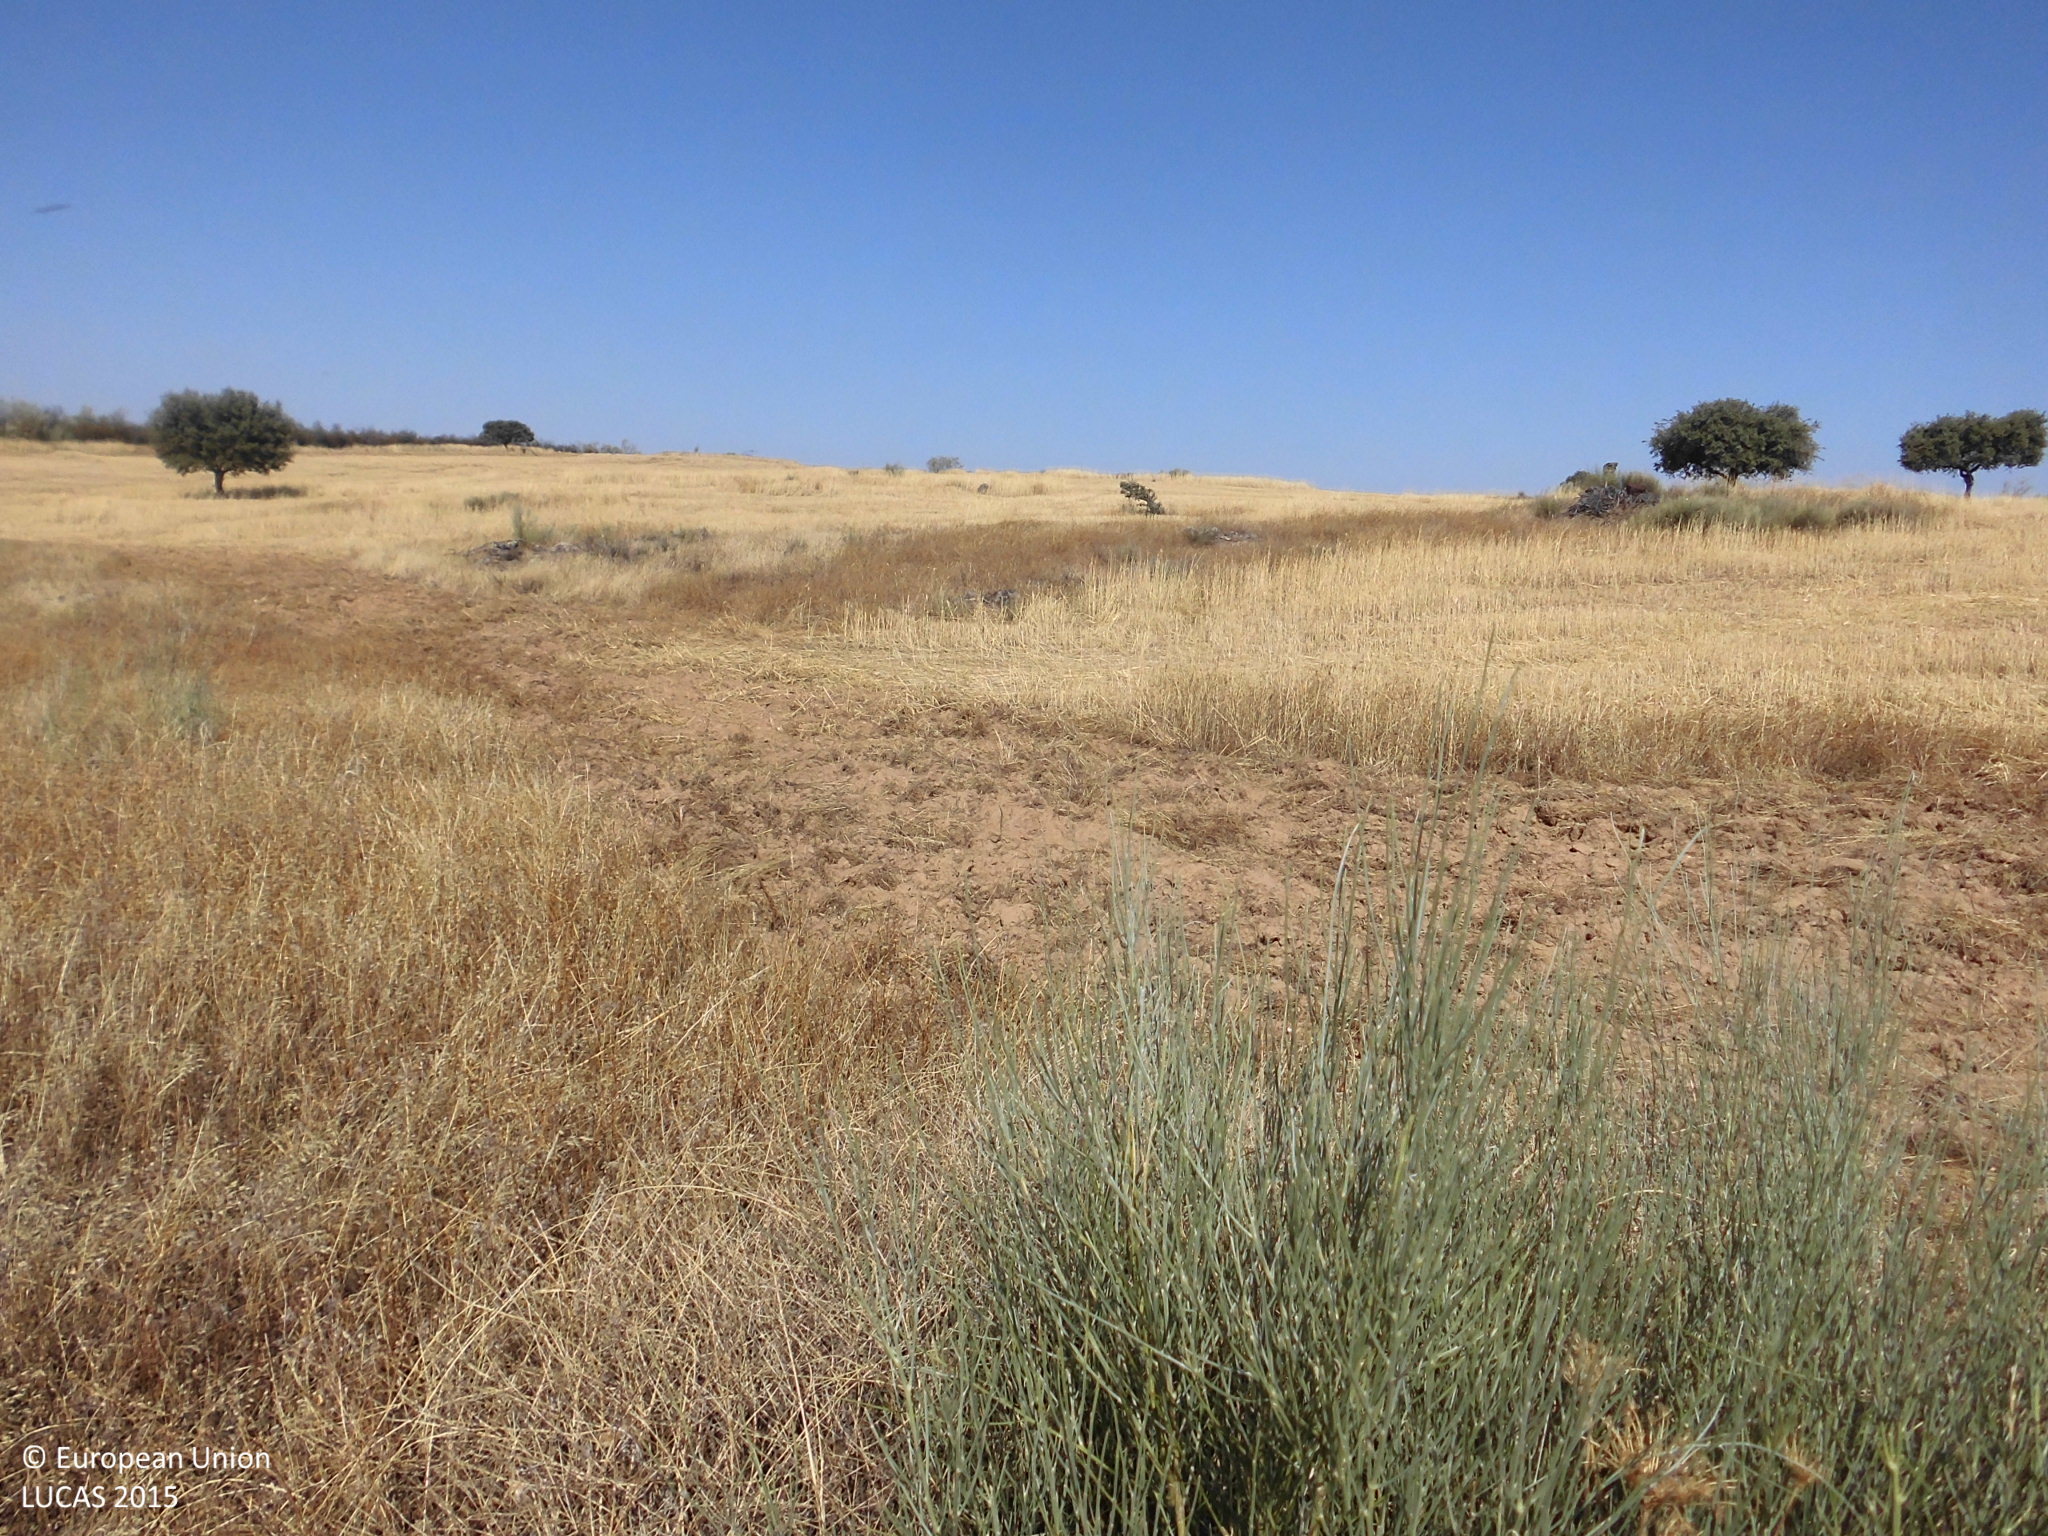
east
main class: Grassland
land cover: Grassland without tree/shrub cover
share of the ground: > 75 %
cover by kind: herbaceous plants 95 %, shrubs 5 %
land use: Agriculture (excluding fallow land and kitchen gardens)
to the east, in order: Grassland without tree/shrub cover; Barley
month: July
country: ES
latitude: 40.0618
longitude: -6.5776
